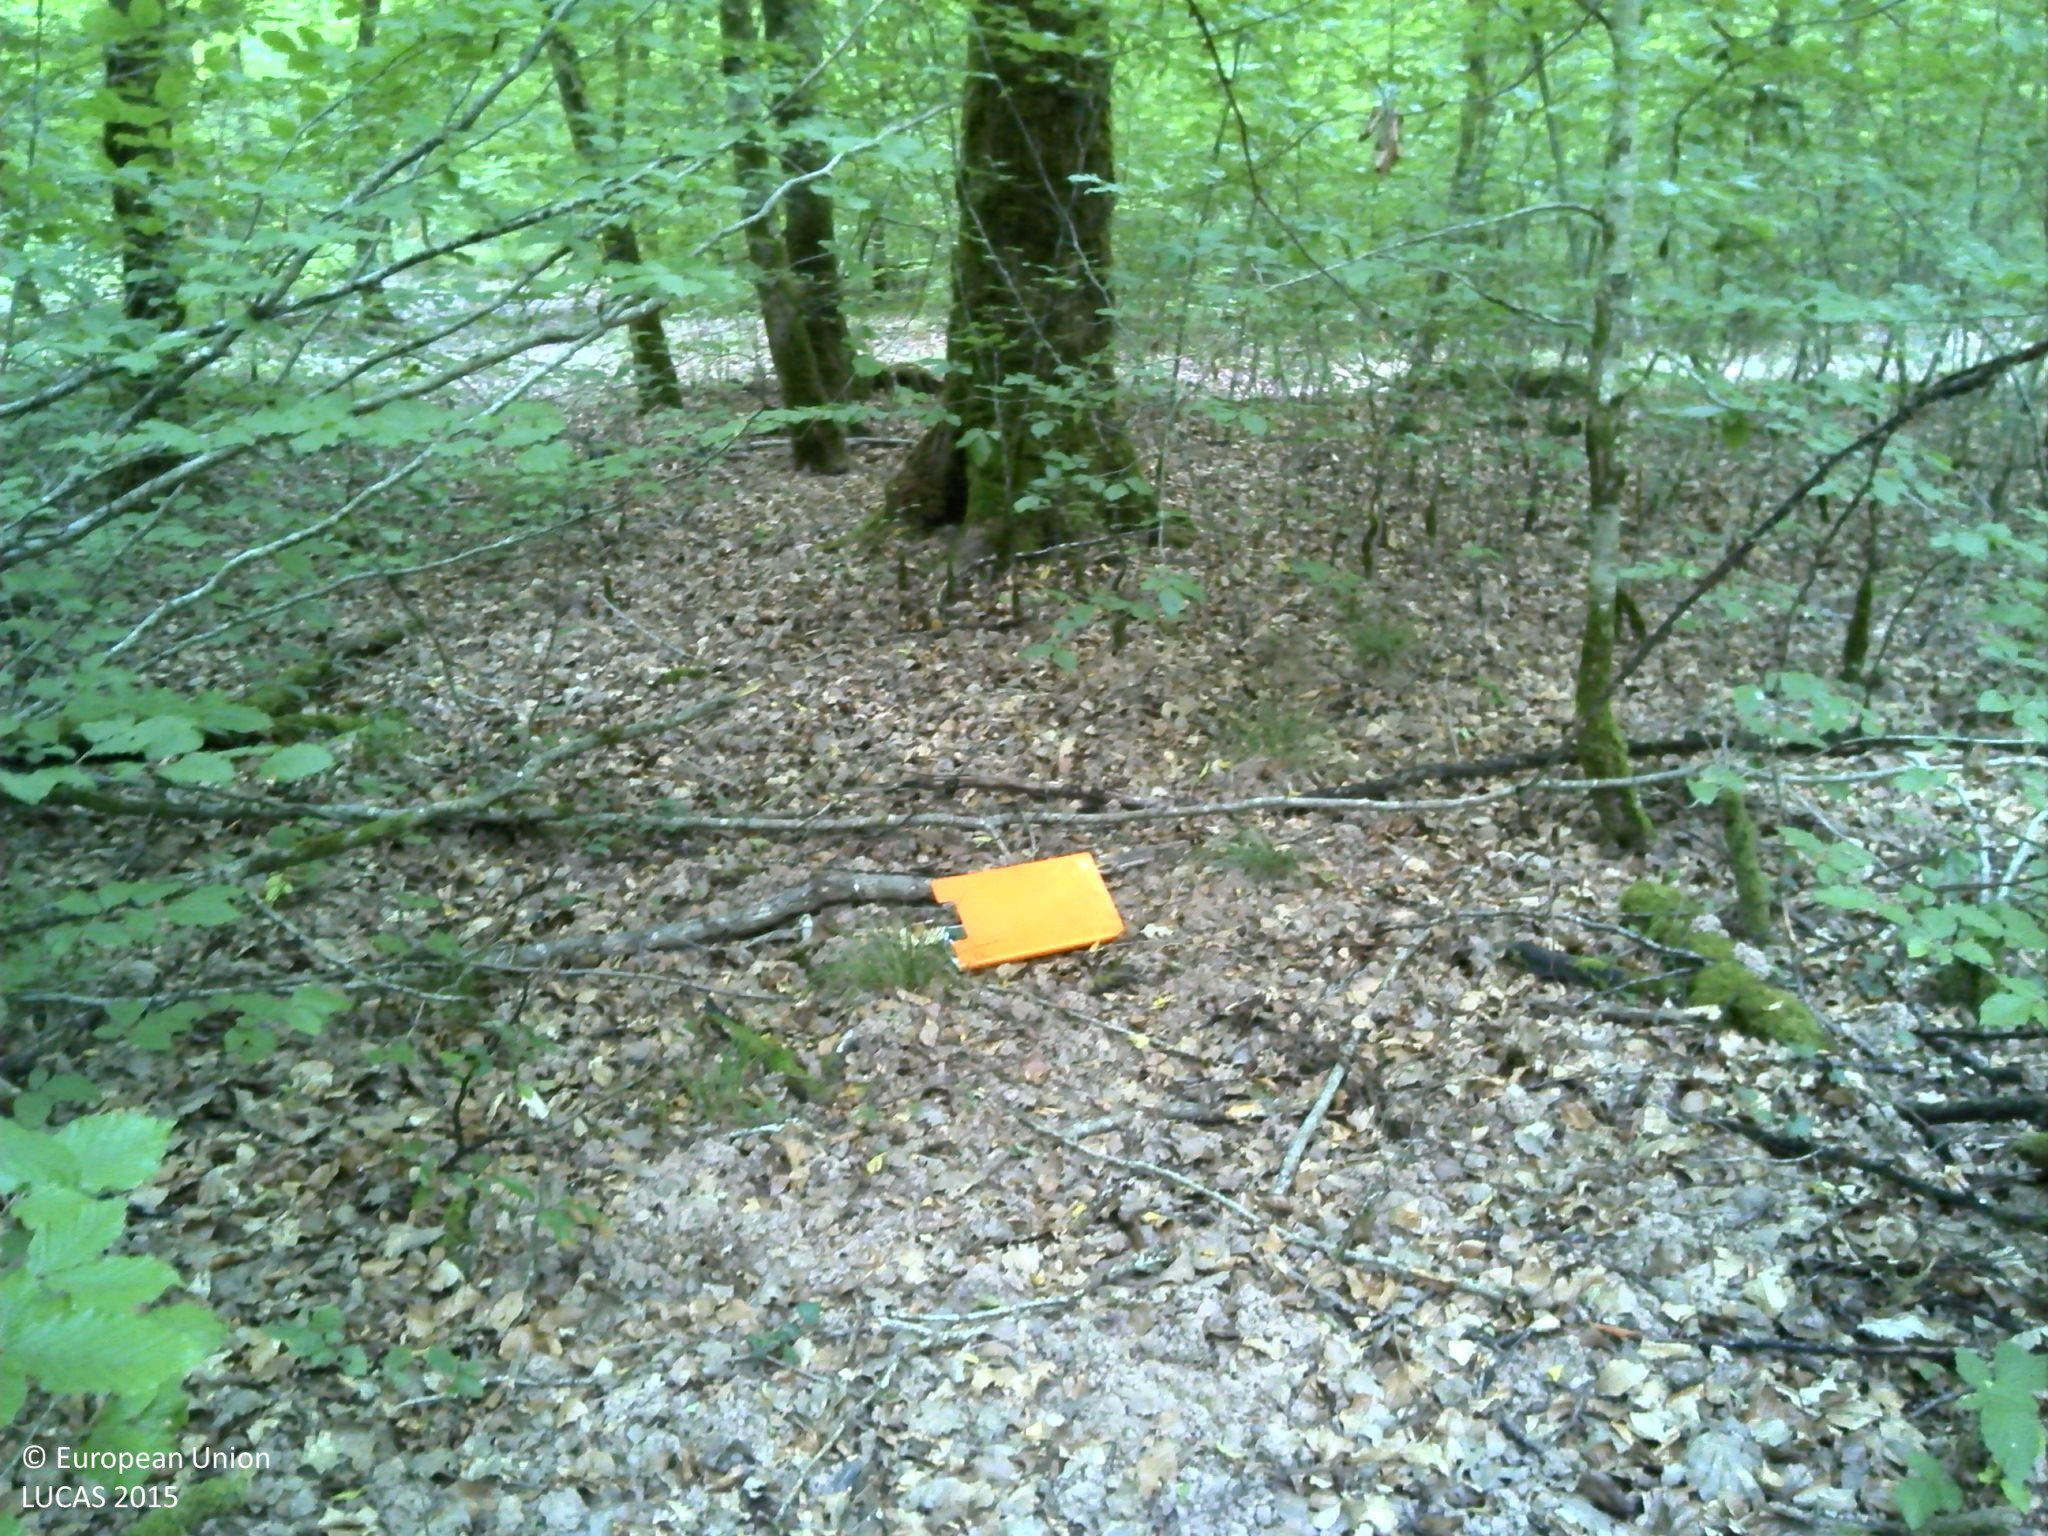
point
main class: Woodland
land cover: Broadleaved woodland
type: beech forest
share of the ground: > 75 %
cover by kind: broadleaved forest trees 100 %
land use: Forestry
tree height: > 5 m
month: July
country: FR
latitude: 48.1003
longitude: 6.0928
